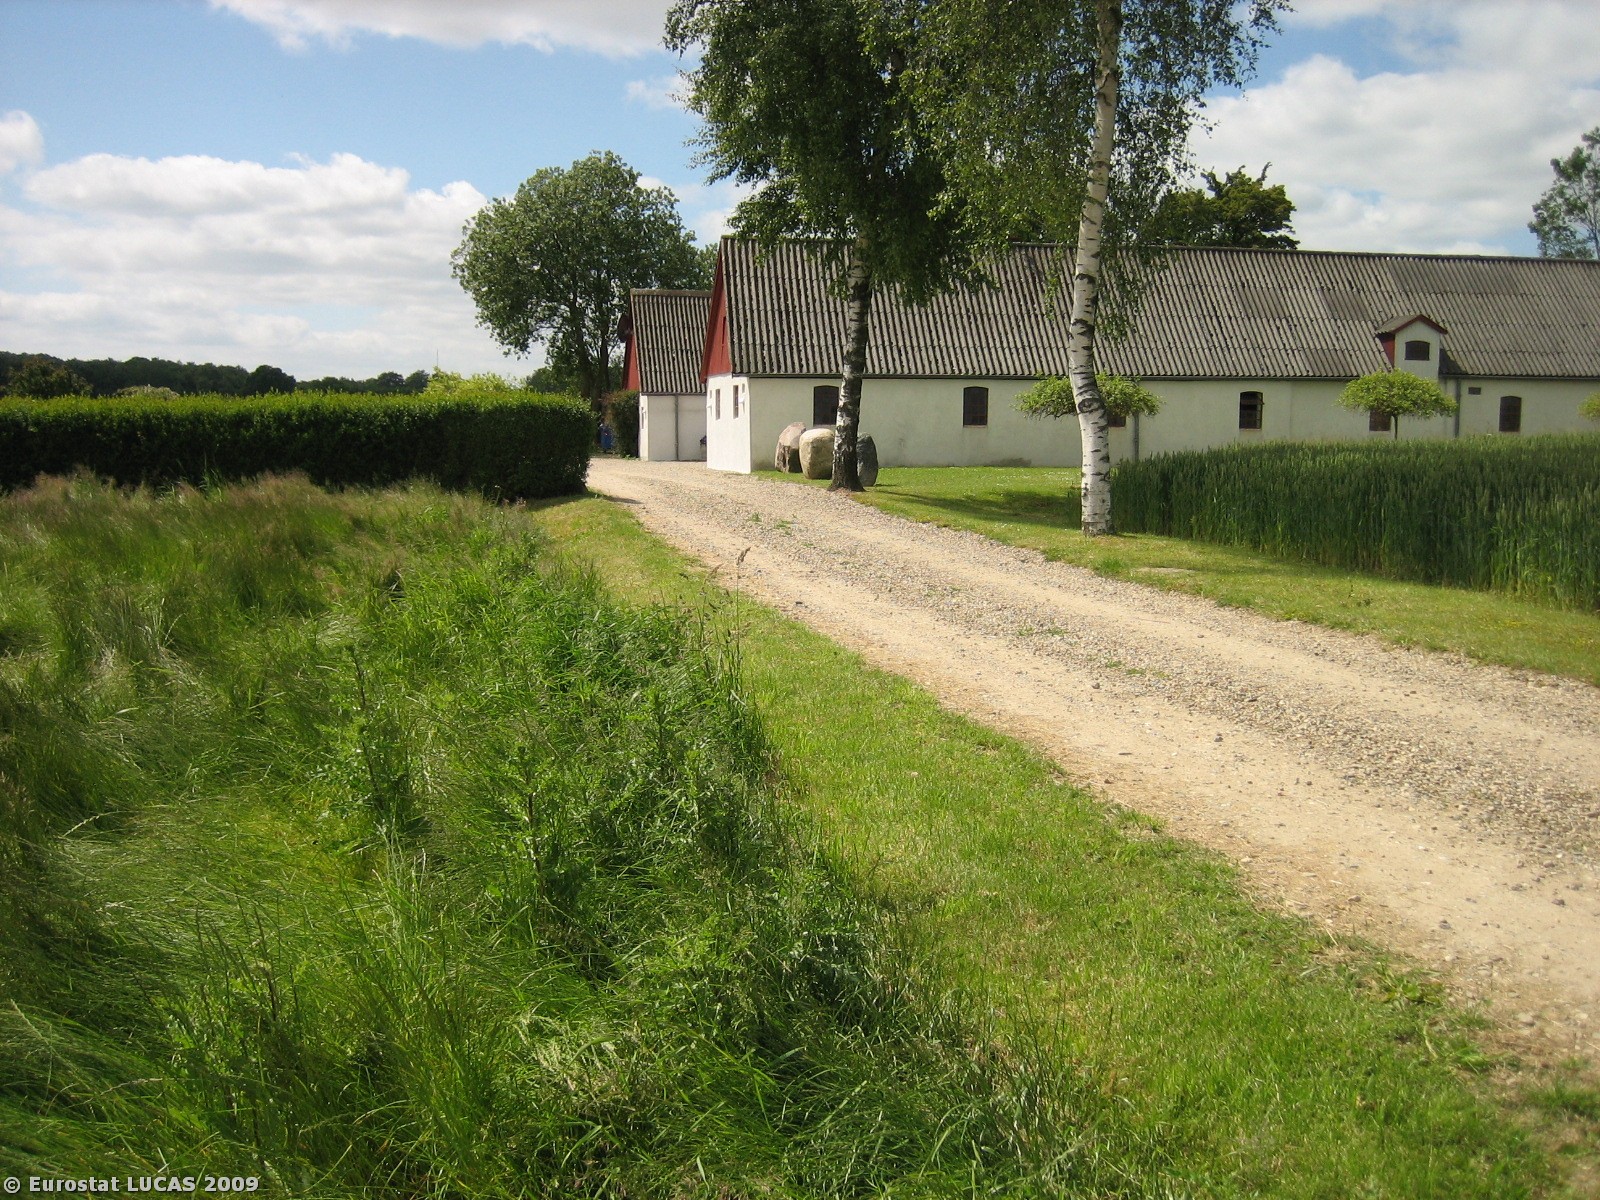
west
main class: Artificial land
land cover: Non built-up linear features
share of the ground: > 75 %
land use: Residential
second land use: Road transport
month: June
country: DK
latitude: 55.8279
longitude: 9.7289
